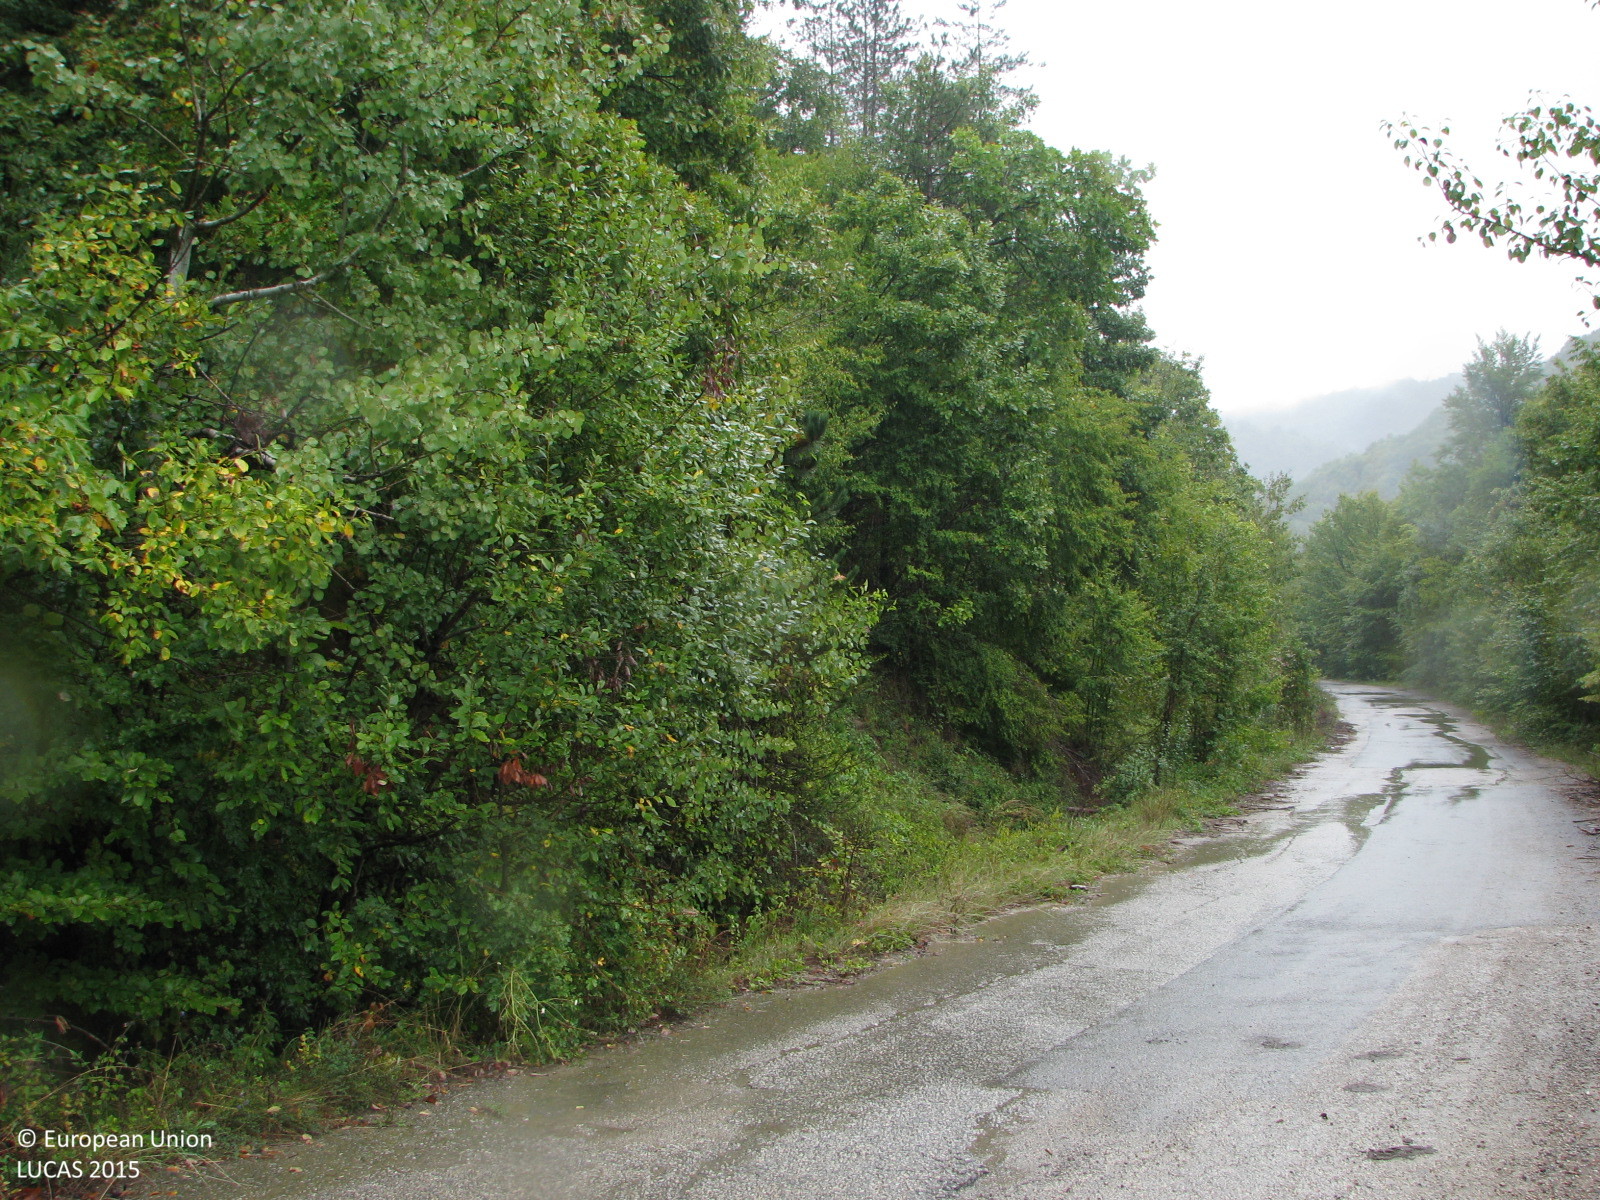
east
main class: Woodland
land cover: Broadleaved woodland
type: mesophytic deciduous forest
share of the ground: > 75 %
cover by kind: broadleaved forest trees 100 %
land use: Forestry
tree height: > 5 m
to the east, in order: Broadleaved woodland; Rivers and streams; Broadleaved woodland; Grass margins; Paved roads, cycling and walking lanes; Grass margins; Ditches and canals; Broadleaved woodland
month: September
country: BG
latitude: 42.9633
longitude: 26.3883
